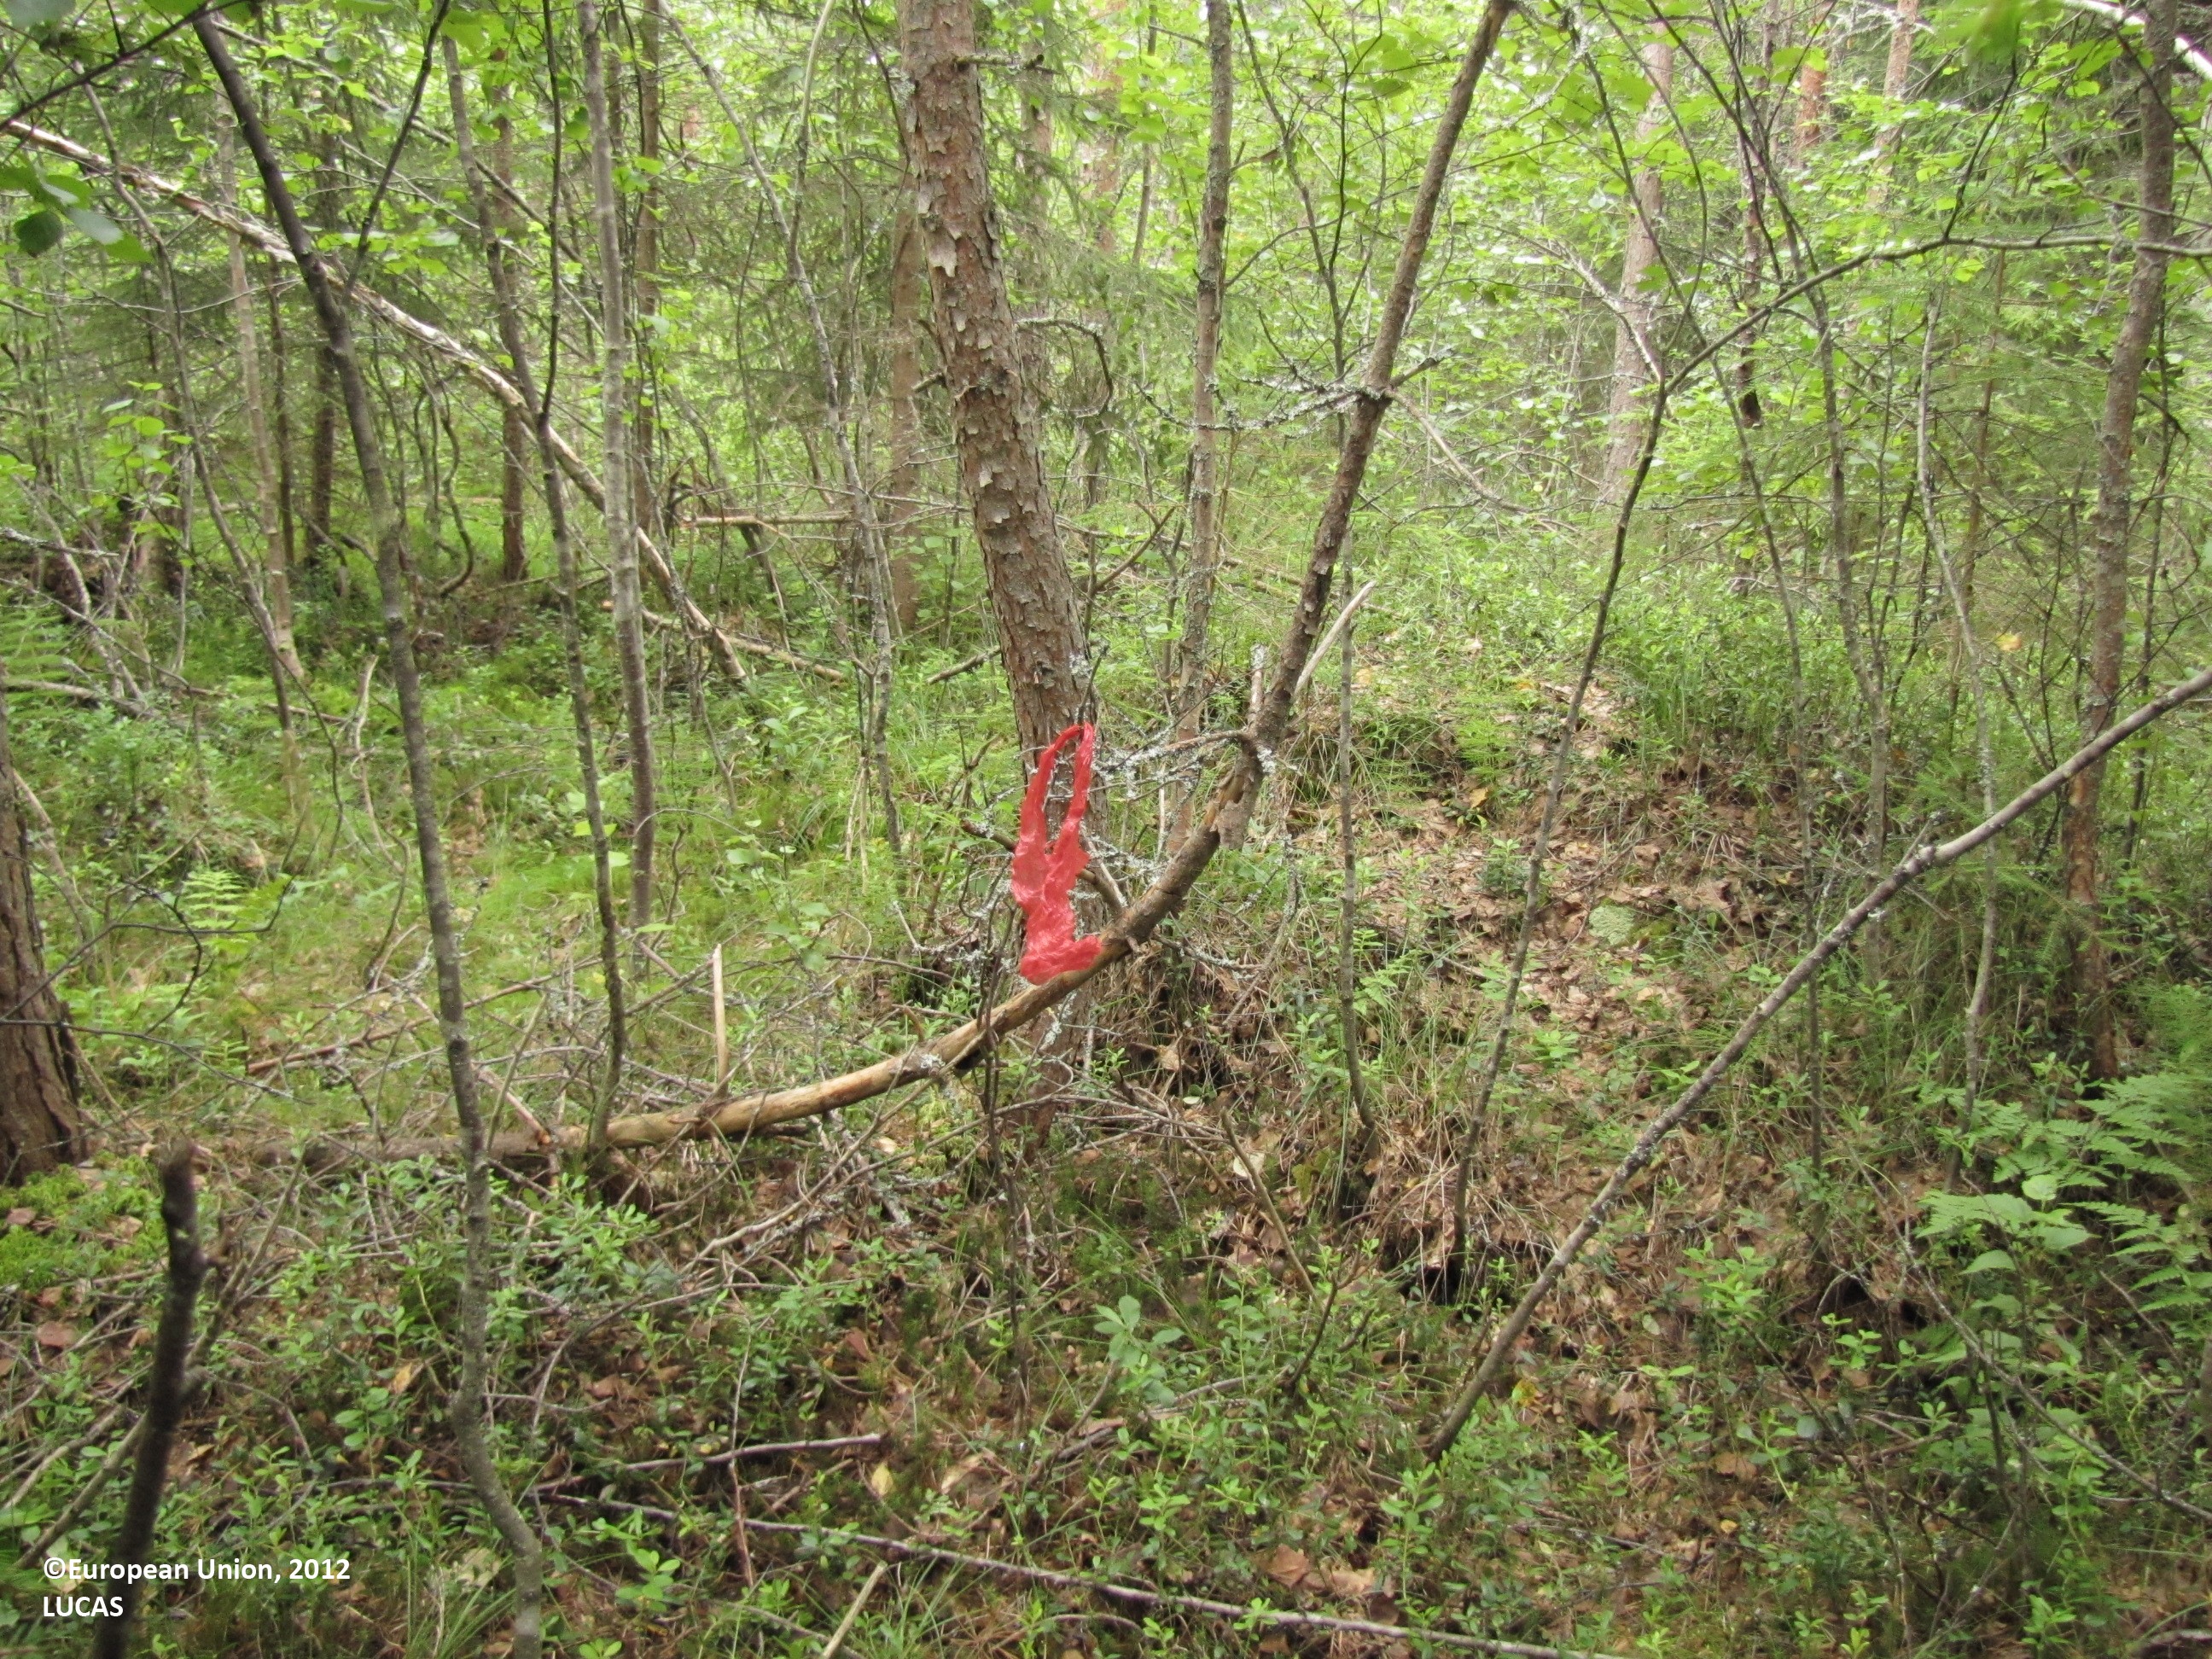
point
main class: Woodland
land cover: Pine dominated mixed woodland
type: mire and swamp forests
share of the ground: > 75 %
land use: Forestry
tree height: > 5 m
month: July
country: FI
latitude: 62.2809
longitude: 23.0350
